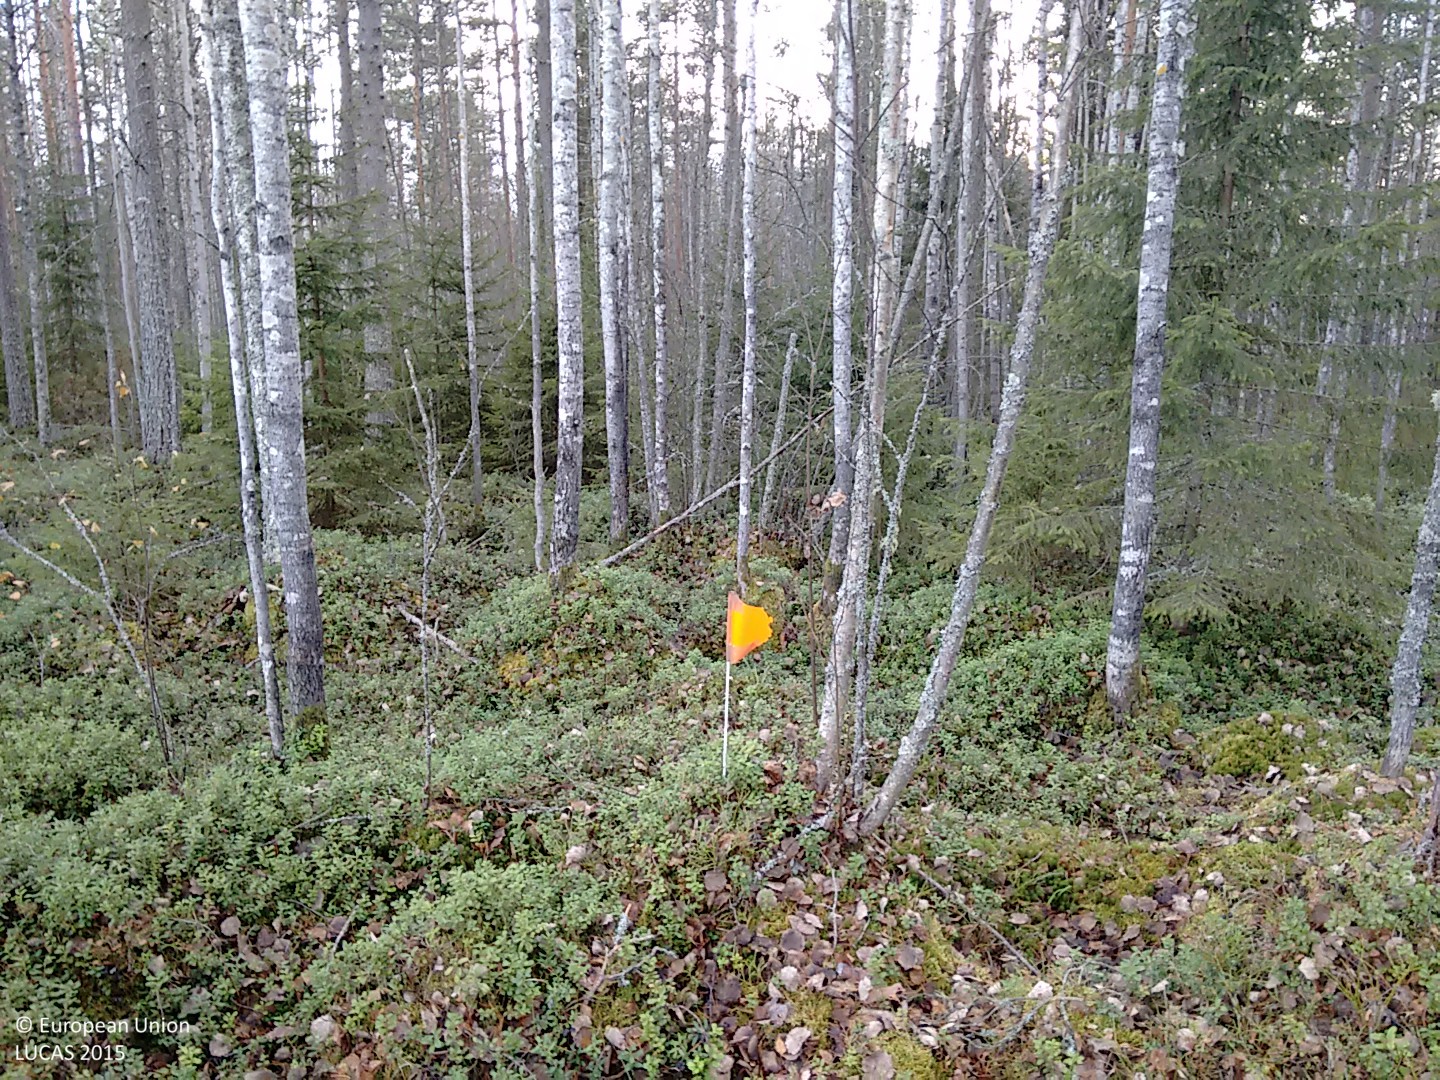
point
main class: Woodland
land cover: Pine dominated mixed woodland
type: boreal forest
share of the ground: > 75 %
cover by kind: broadleaved forest trees 45 %, coniferous forest trees 40 %, shrubs 10 %, herbaceous plants 5 %
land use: Forestry
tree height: > 5 m
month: October
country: FI
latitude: 63.9264
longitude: 25.1172
